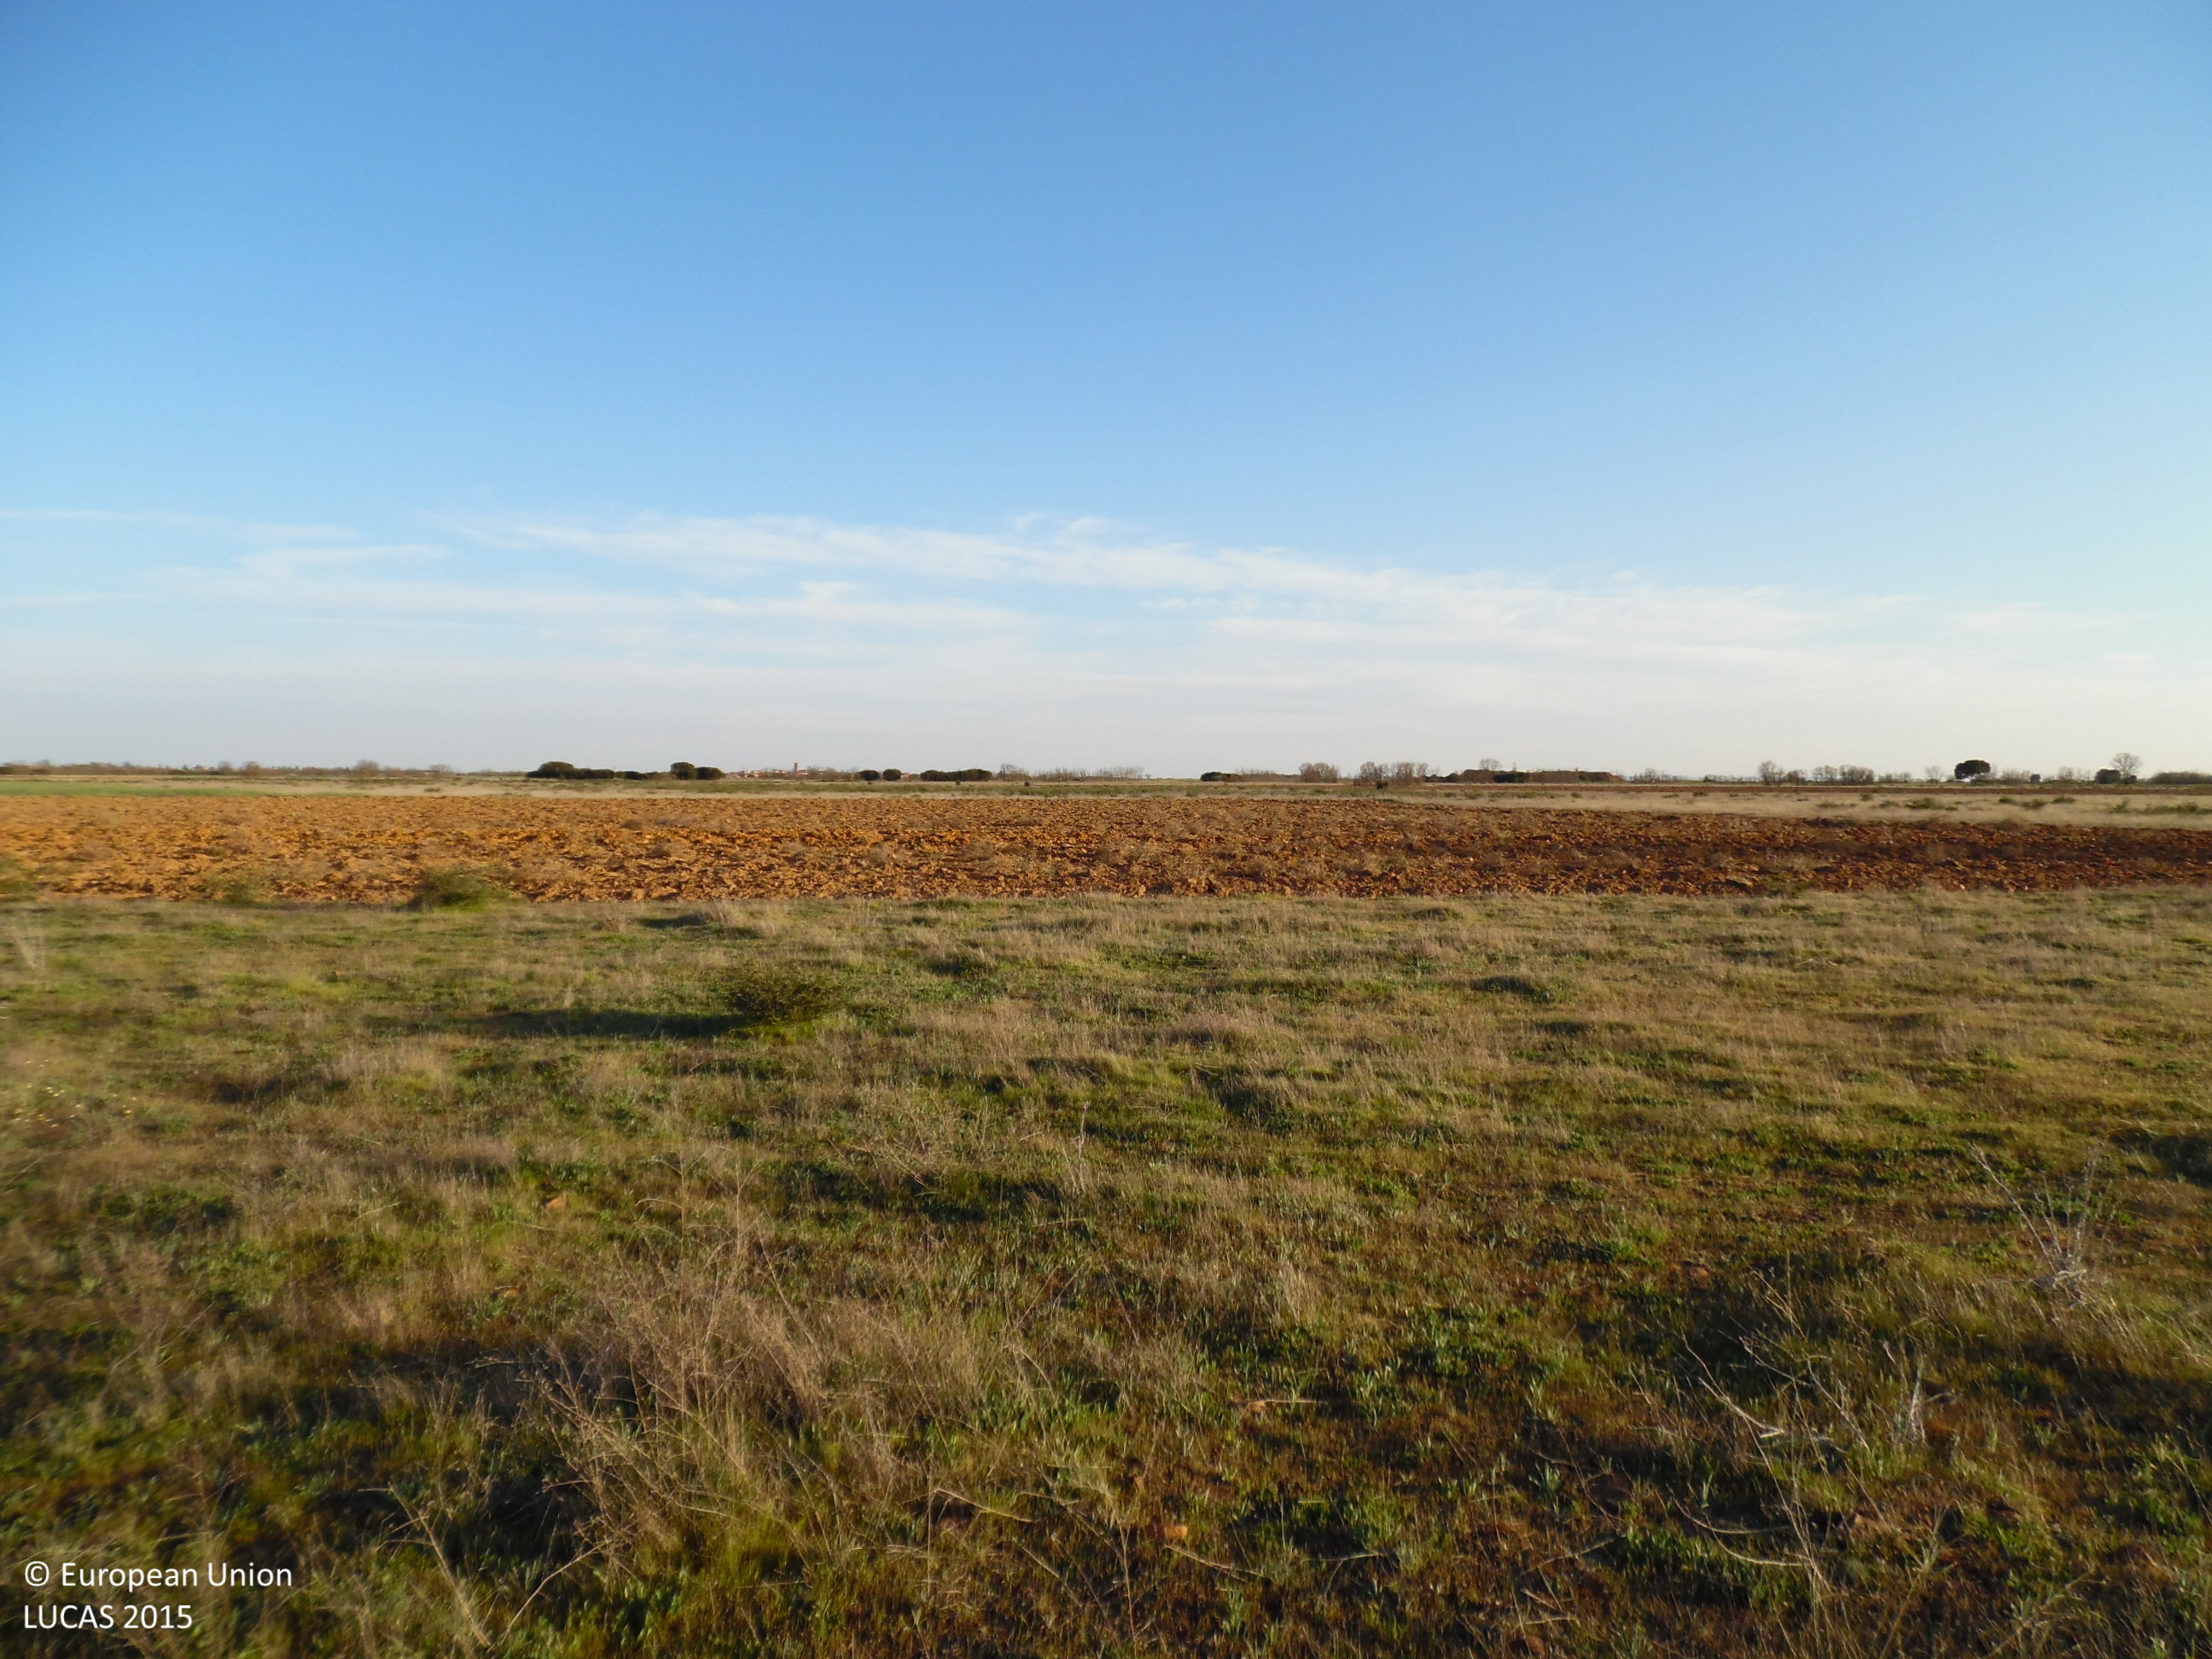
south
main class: Grassland
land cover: Spontaneously vegetated surfaces
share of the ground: > 75 %
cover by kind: herbaceous plants 95 %, shrubs 5 %
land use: Fallow land
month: April
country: ES
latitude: 42.5476
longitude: -5.7736
